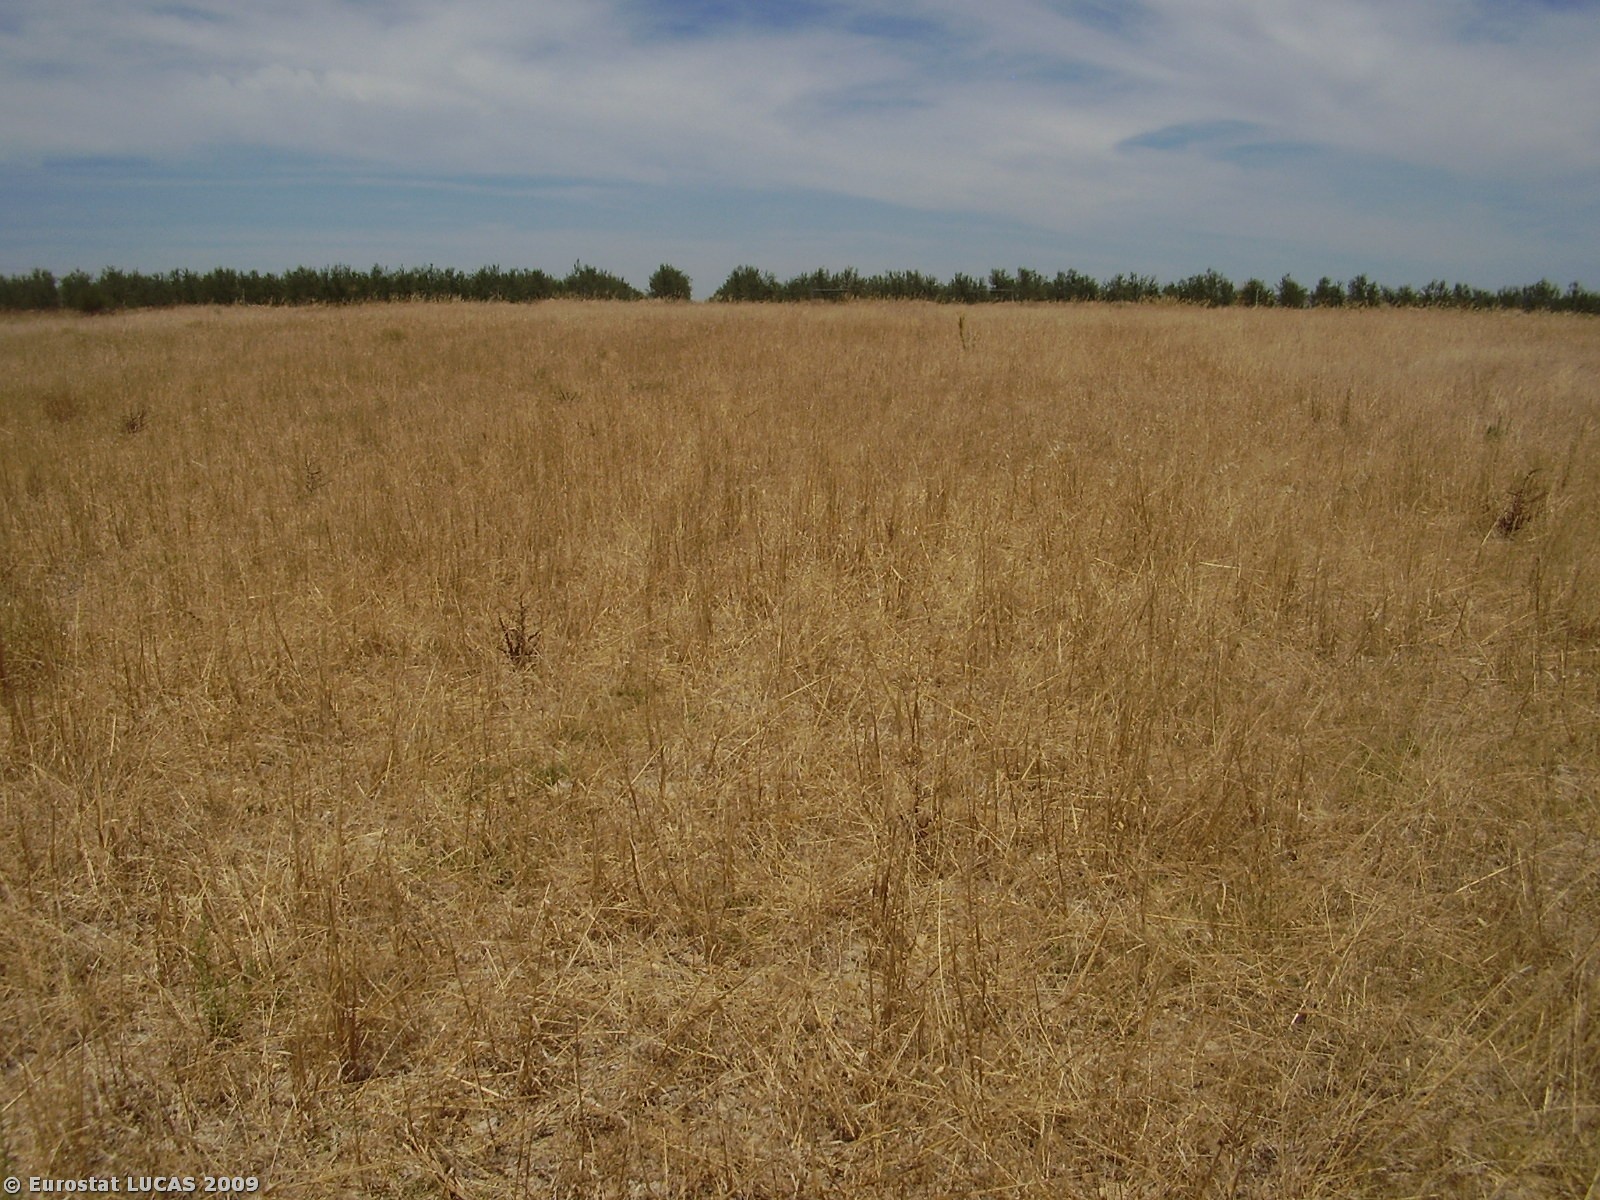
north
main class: Cropland
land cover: Oats
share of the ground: > 75 %
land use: Agriculture (excluding fallow land and kitchen gardens)
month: August
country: PT
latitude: 38.0973
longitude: -7.8520
